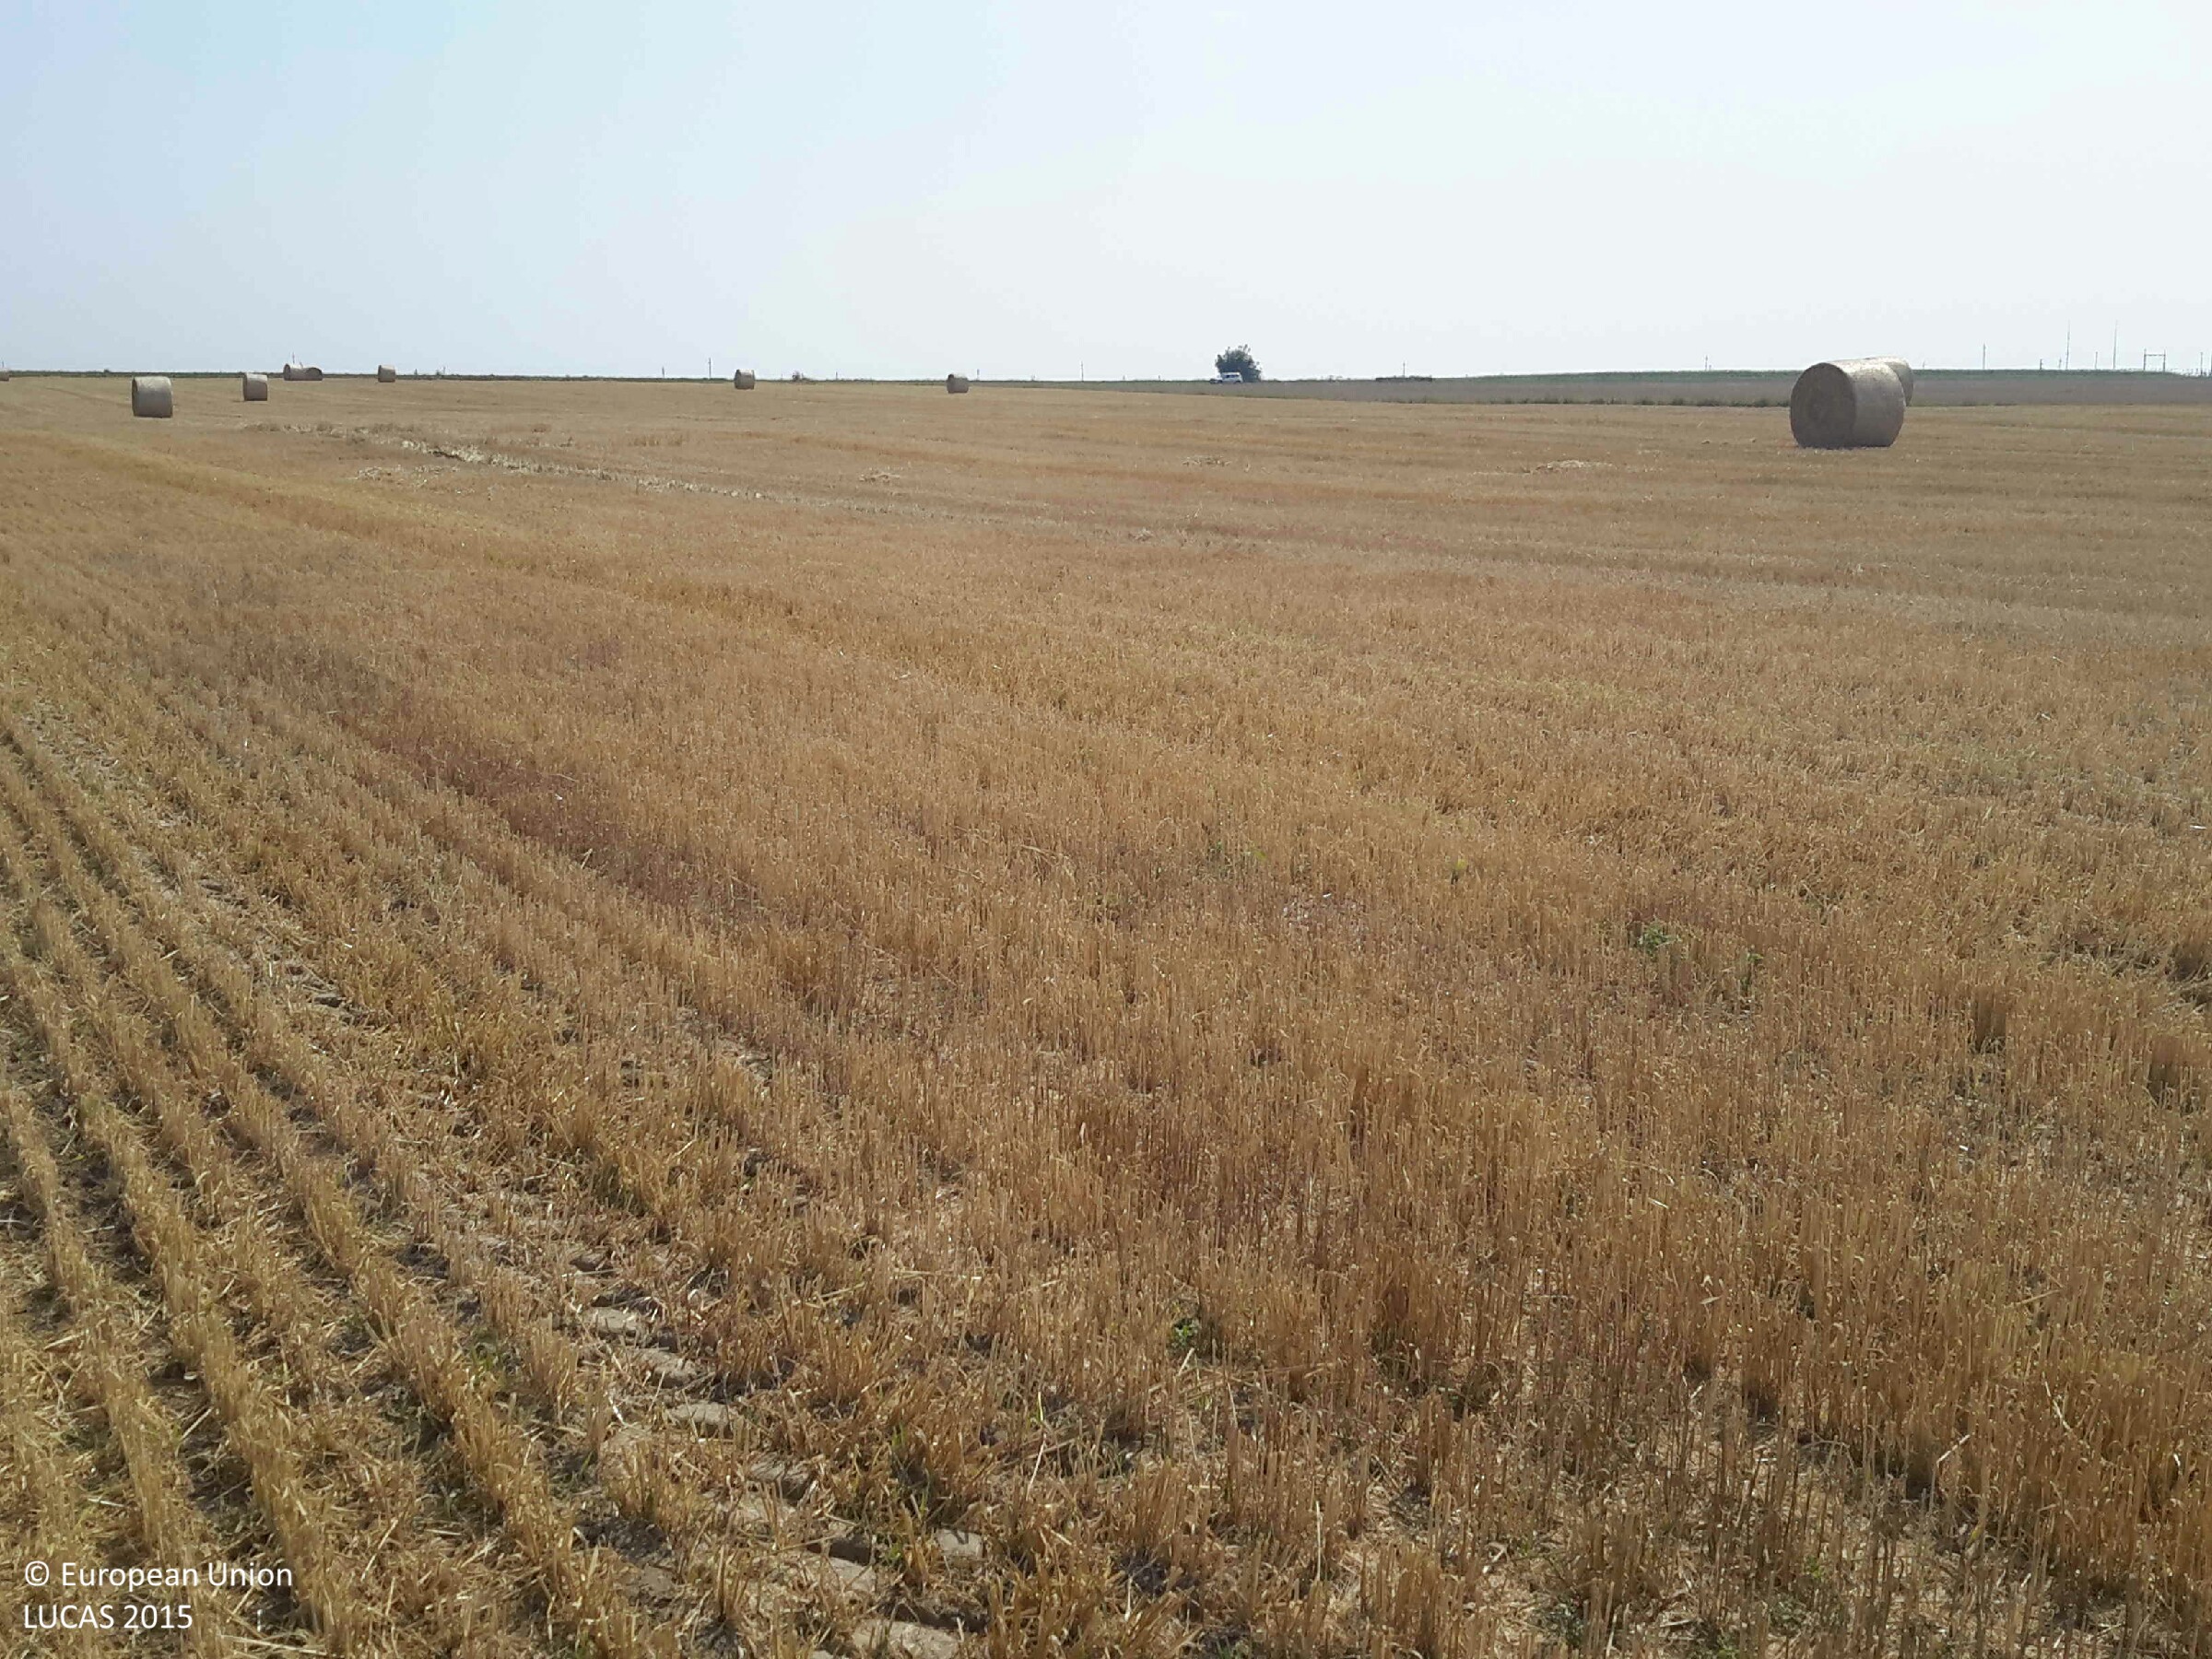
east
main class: Cropland
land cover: Common wheat
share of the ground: 50 - 75 %
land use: Agriculture (excluding fallow land and kitchen gardens)
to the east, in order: Common wheat; Rape and turnip rape
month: July
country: HU
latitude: 47.4043
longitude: 16.7227
